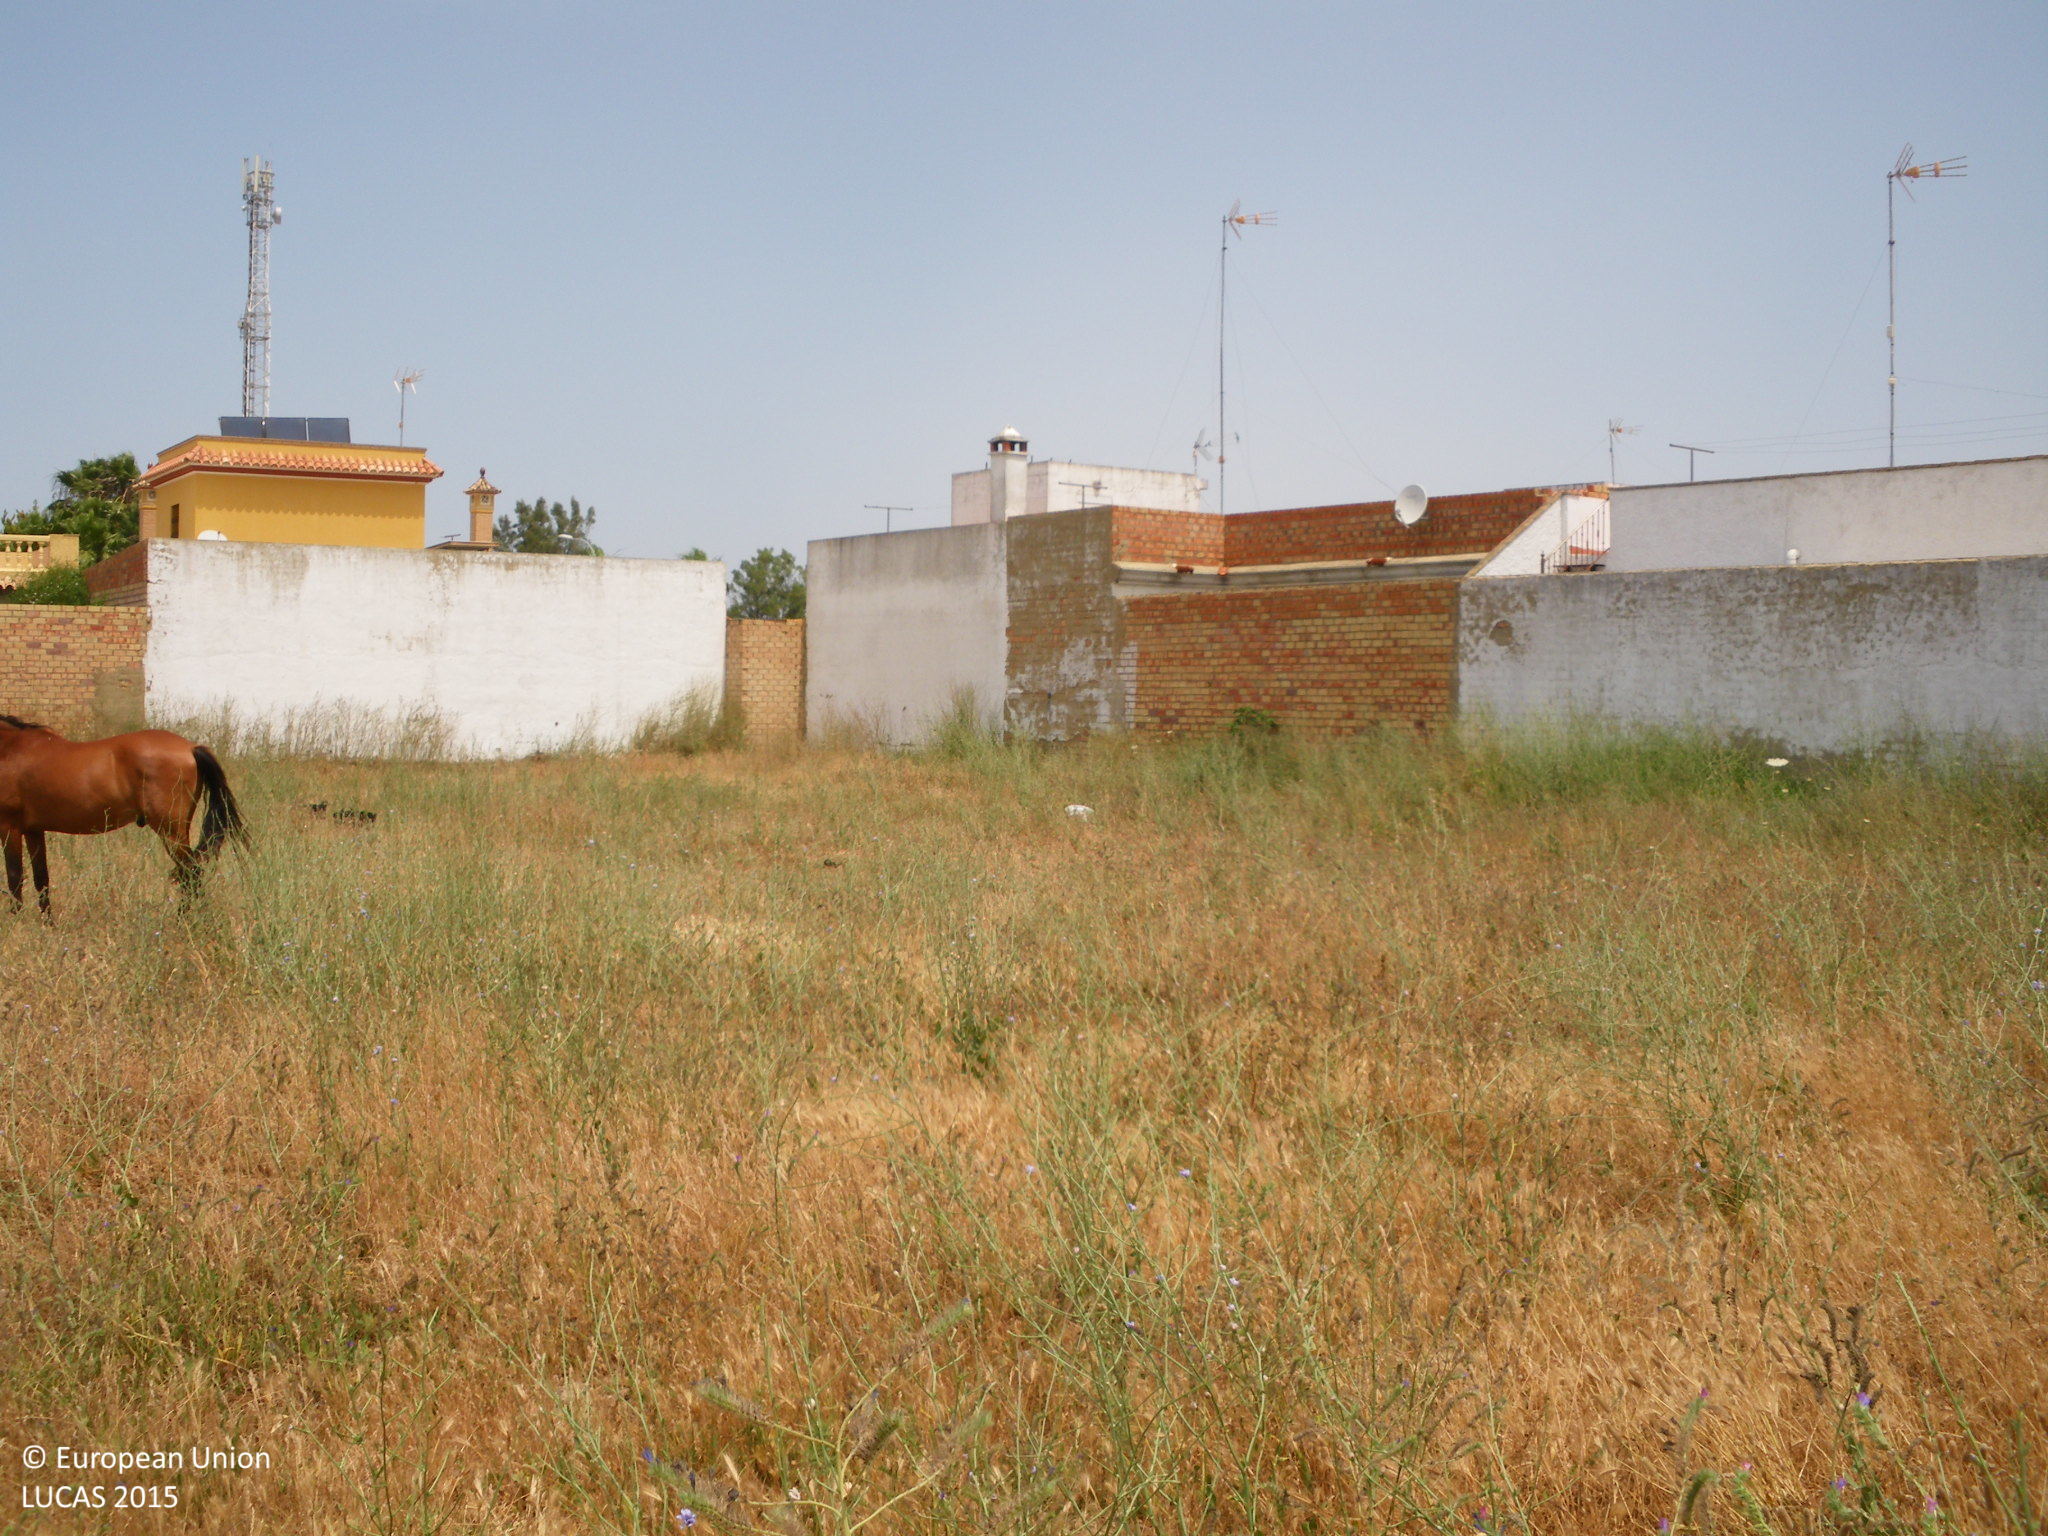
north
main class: Grassland
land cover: Grassland without tree/shrub cover
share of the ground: > 75 %
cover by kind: herbaceous plants 95 %, unconsolidated bare surface 5 %
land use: Agriculture (excluding fallow land and kitchen gardens)
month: June
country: ES
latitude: 36.7337
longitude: -6.4231
